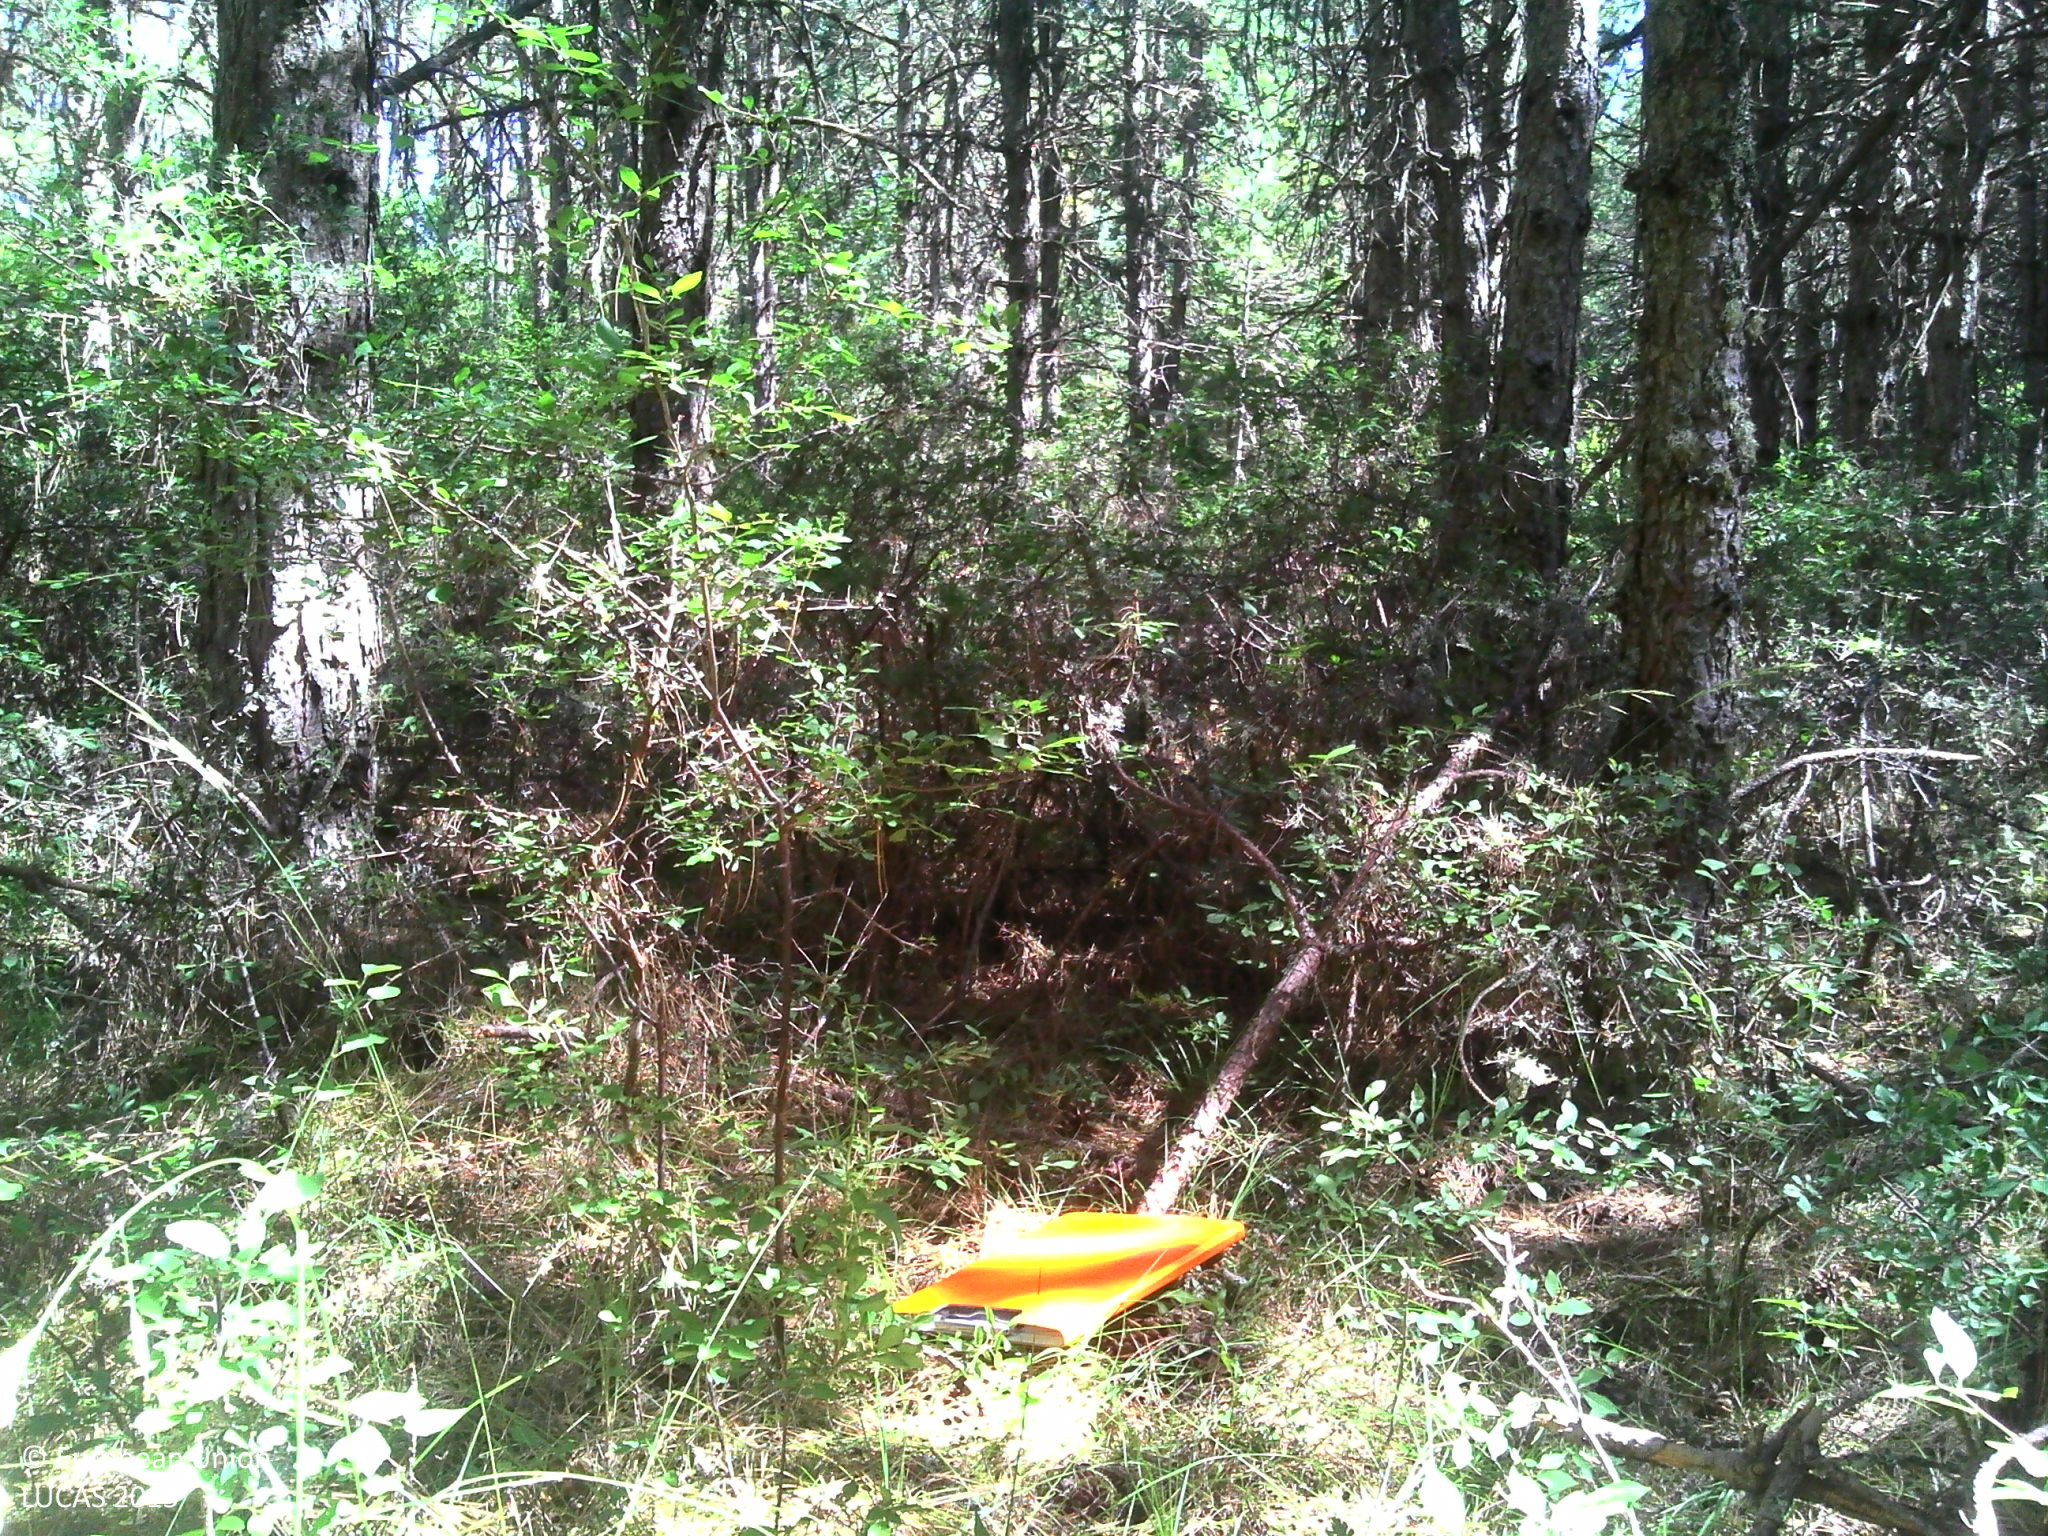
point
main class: Woodland
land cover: Pine dominated coniferous woodland
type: exotic forest
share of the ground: > 75 %
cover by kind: coniferous forest trees 85 %, broadleaved forest trees 5 %, shrubs 5 %, herbaceous plants 5 %
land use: Forestry
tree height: > 5 m
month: July
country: FR
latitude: 44.3637
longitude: 3.2168
